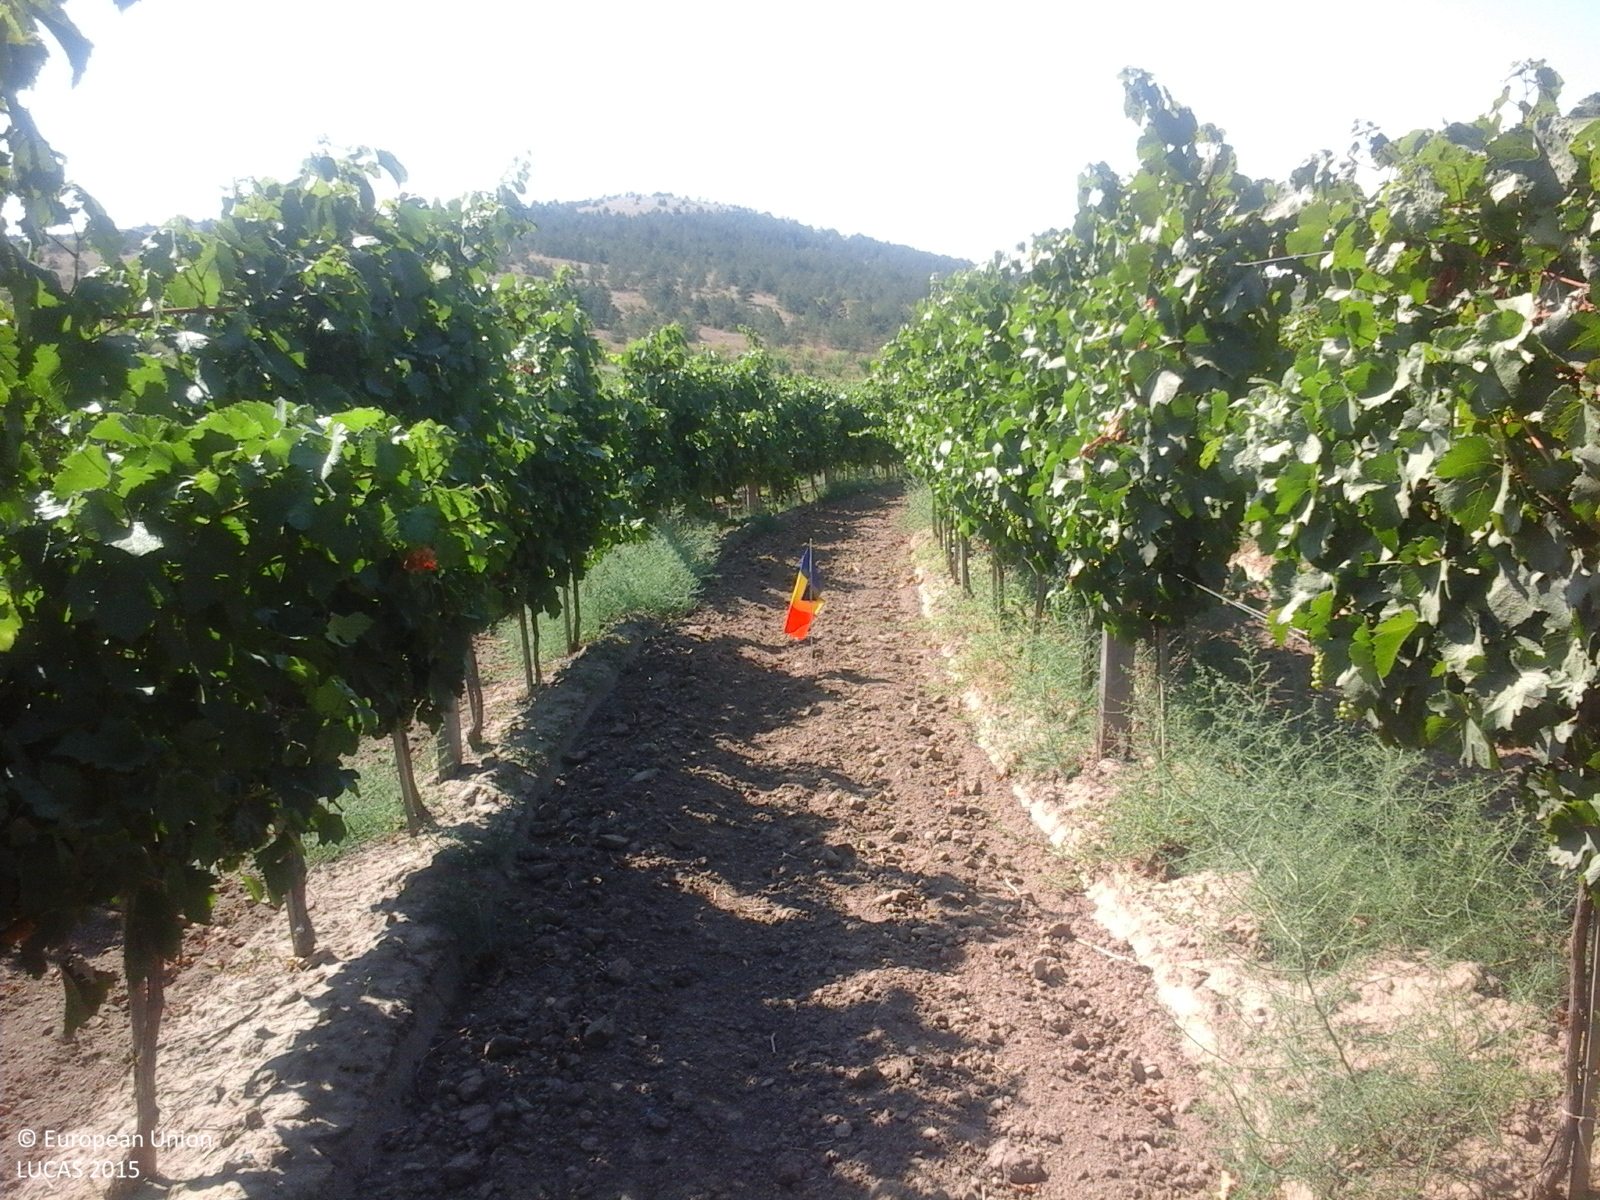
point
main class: Cropland
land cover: Vineyards
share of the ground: 50 - 75 %
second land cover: Other bare soil
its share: > 75 %
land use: Agriculture (excluding fallow land and kitchen gardens)
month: August
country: RO
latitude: 44.5114
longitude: 28.2162
